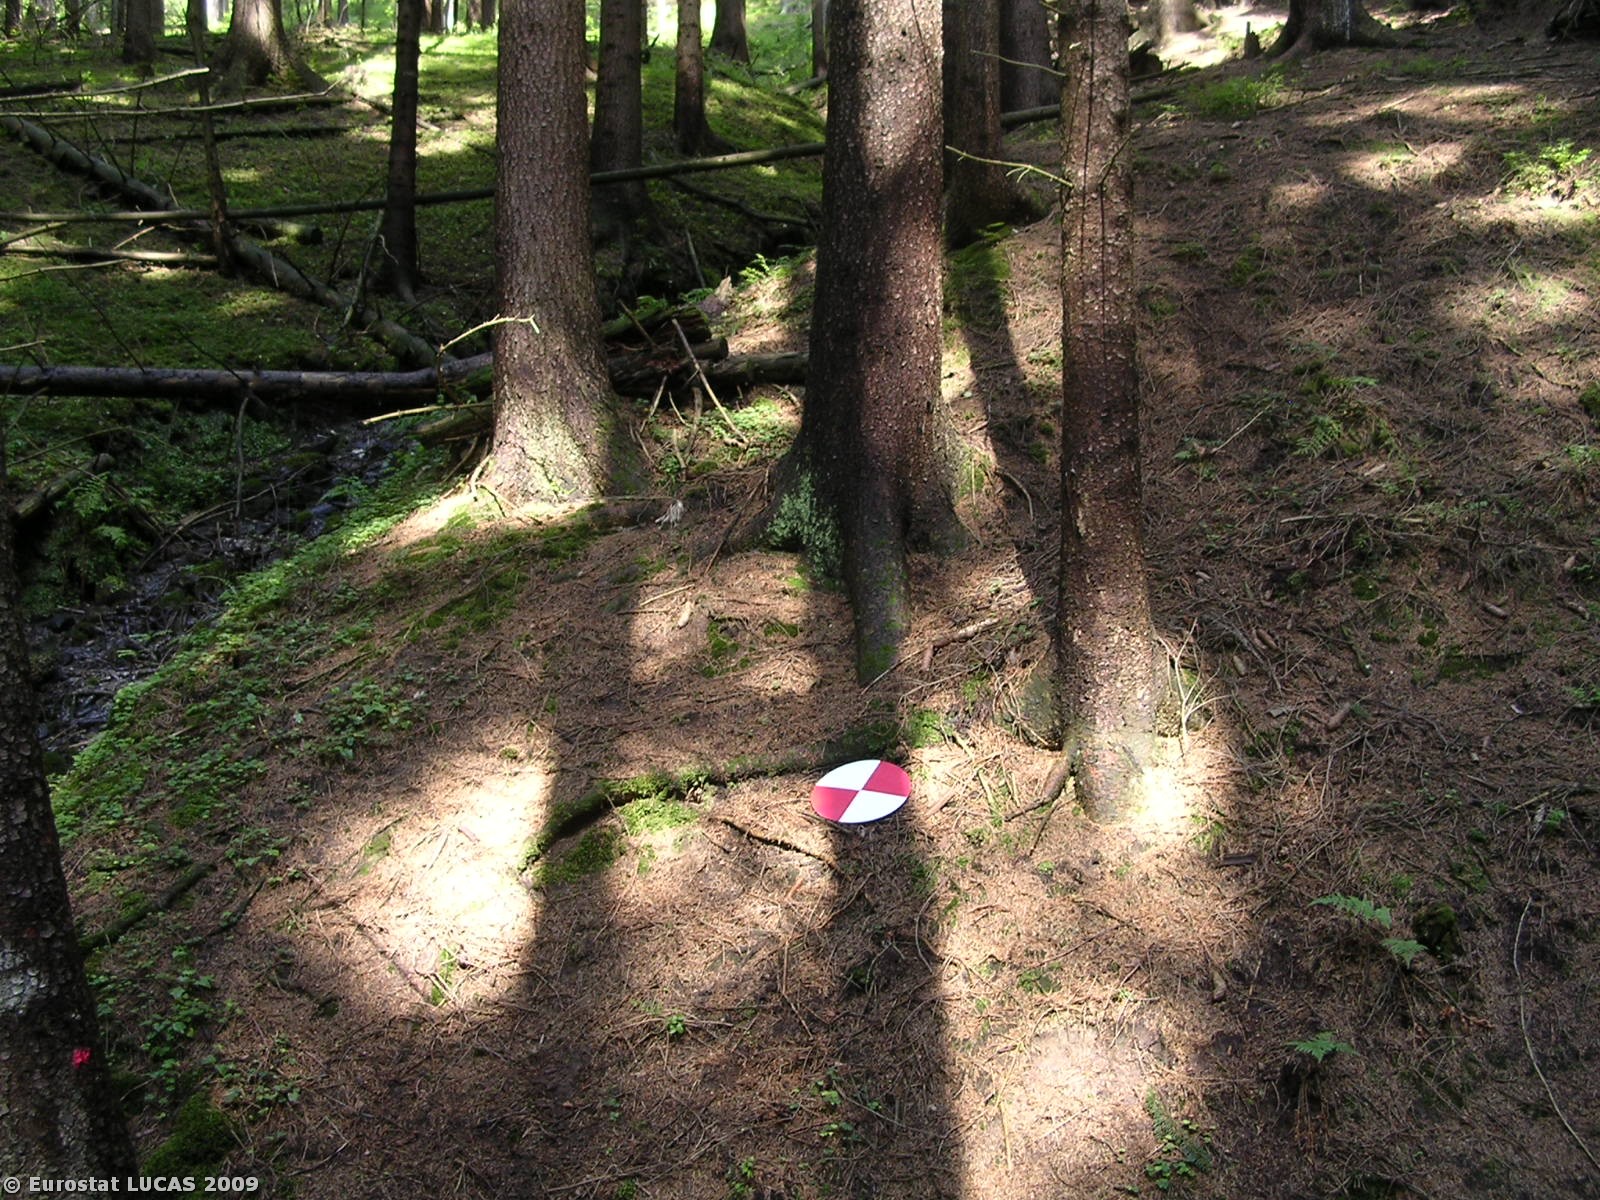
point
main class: Woodland
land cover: Coniferous woodland
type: hemiboreal forest and nemoral coniferous forest and mixed broadleaved-coniferous forest
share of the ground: > 75 %
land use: Forestry
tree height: > 5 m
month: July
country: CZ
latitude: 50.6705
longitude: 14.9693
